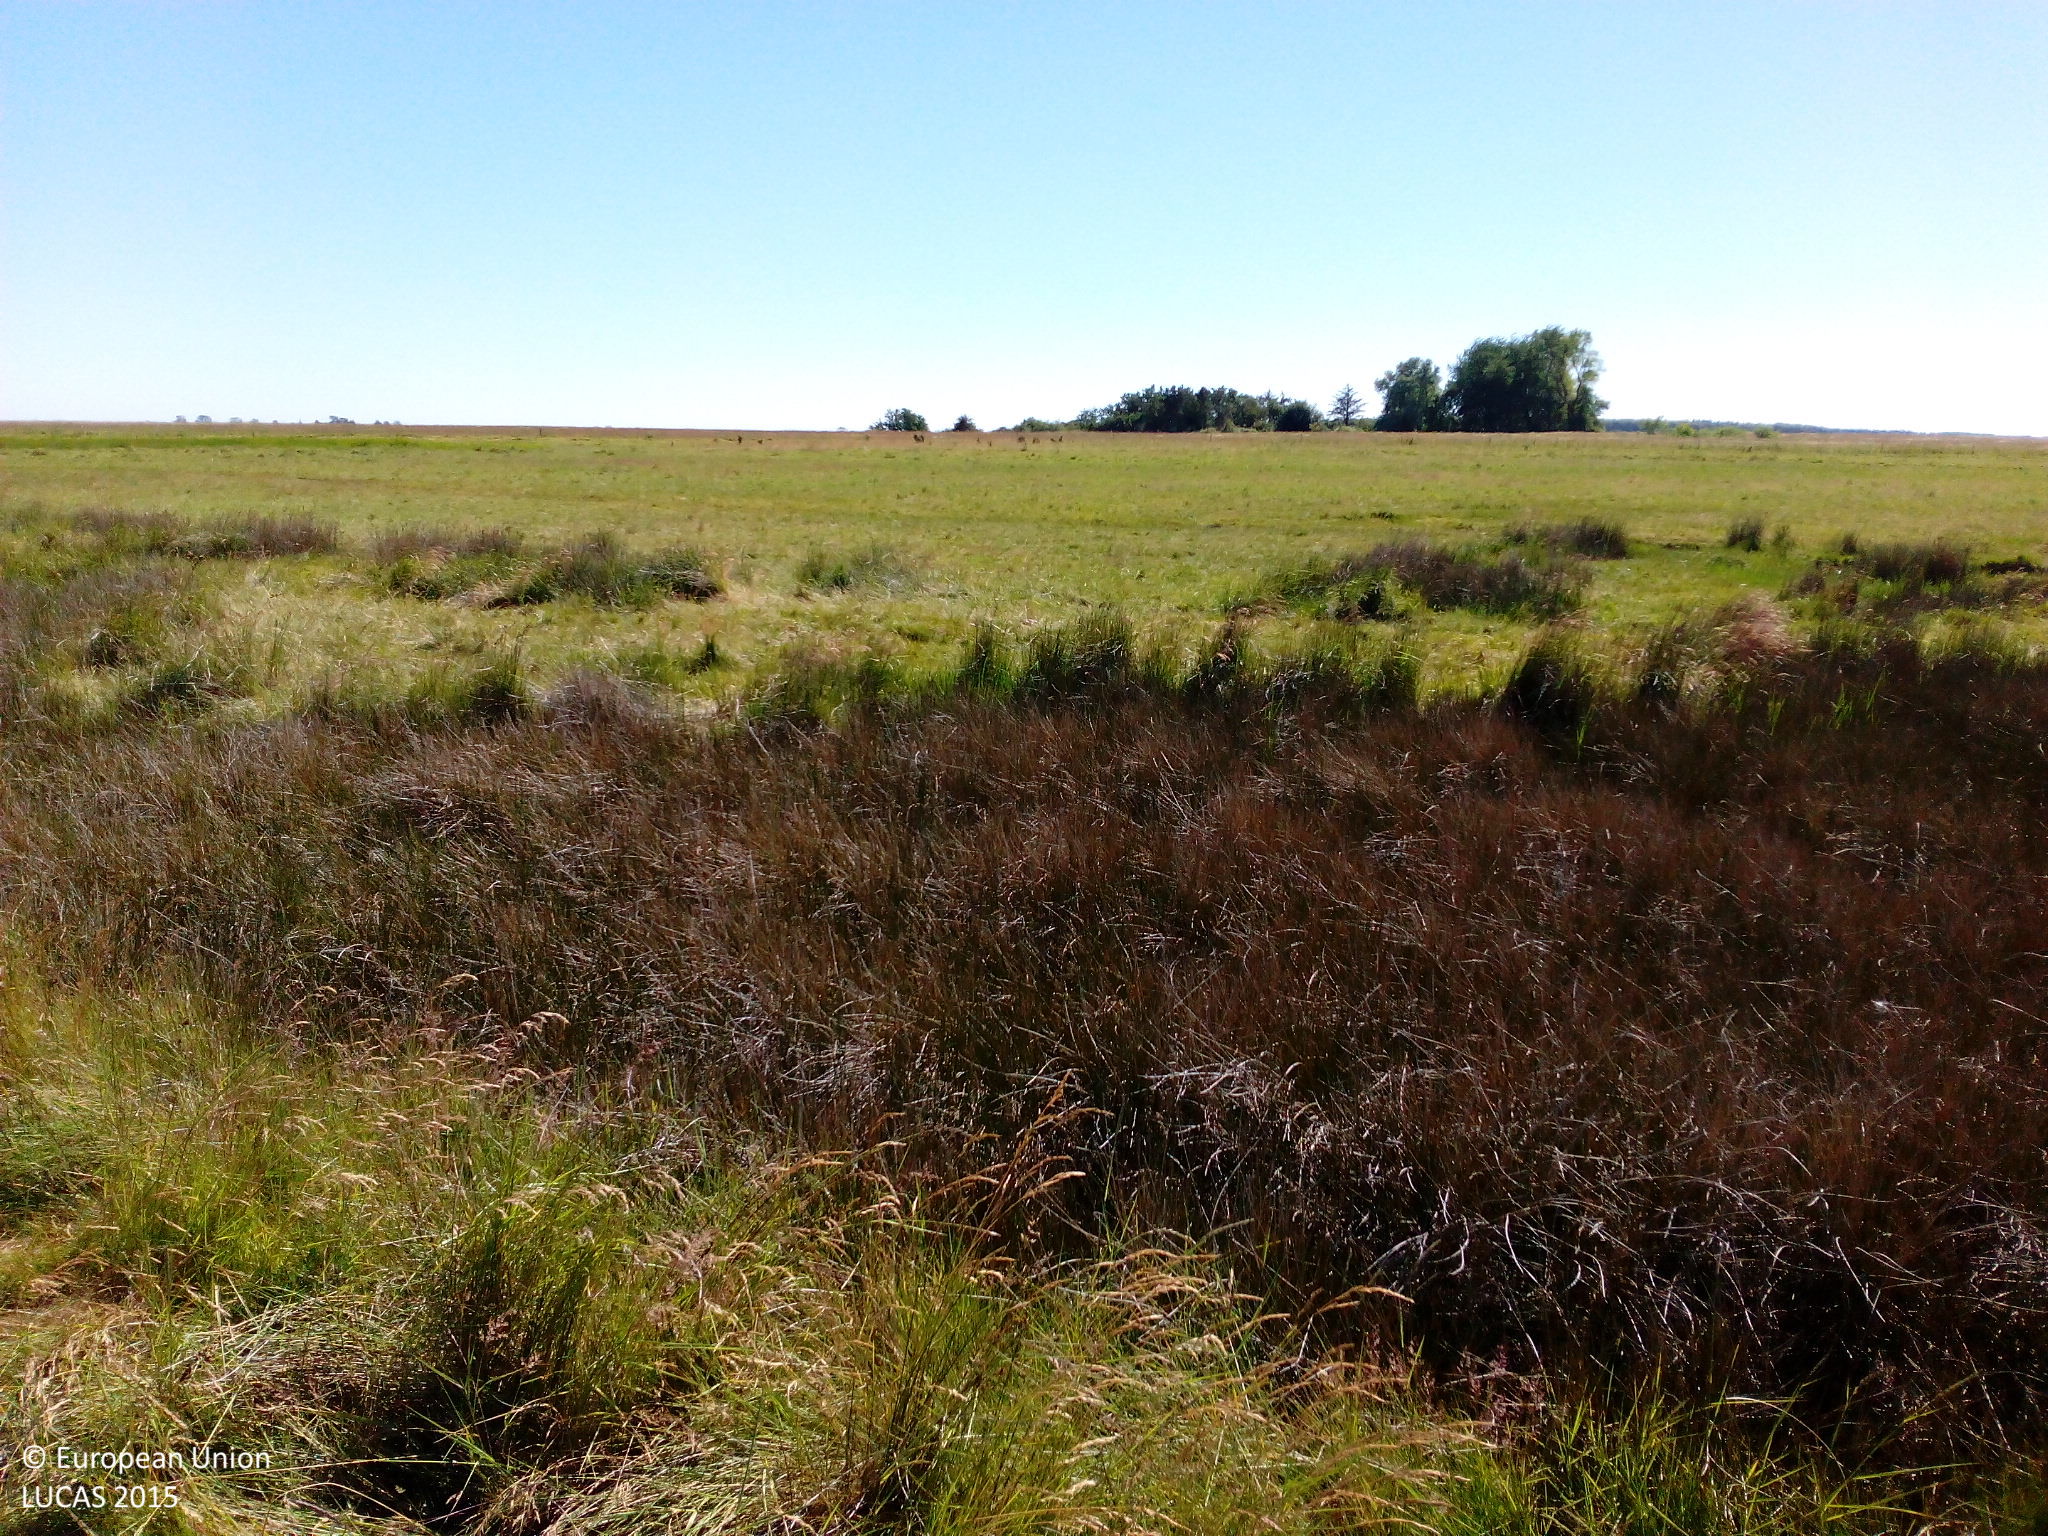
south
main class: Grassland
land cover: Grassland without tree/shrub cover
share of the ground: > 75 %
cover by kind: herbaceous plants 100 %
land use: Agriculture (excluding fallow land and kitchen gardens)
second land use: Amenities, museums, leisure
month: July
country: DK
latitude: 55.0789
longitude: 11.7687
